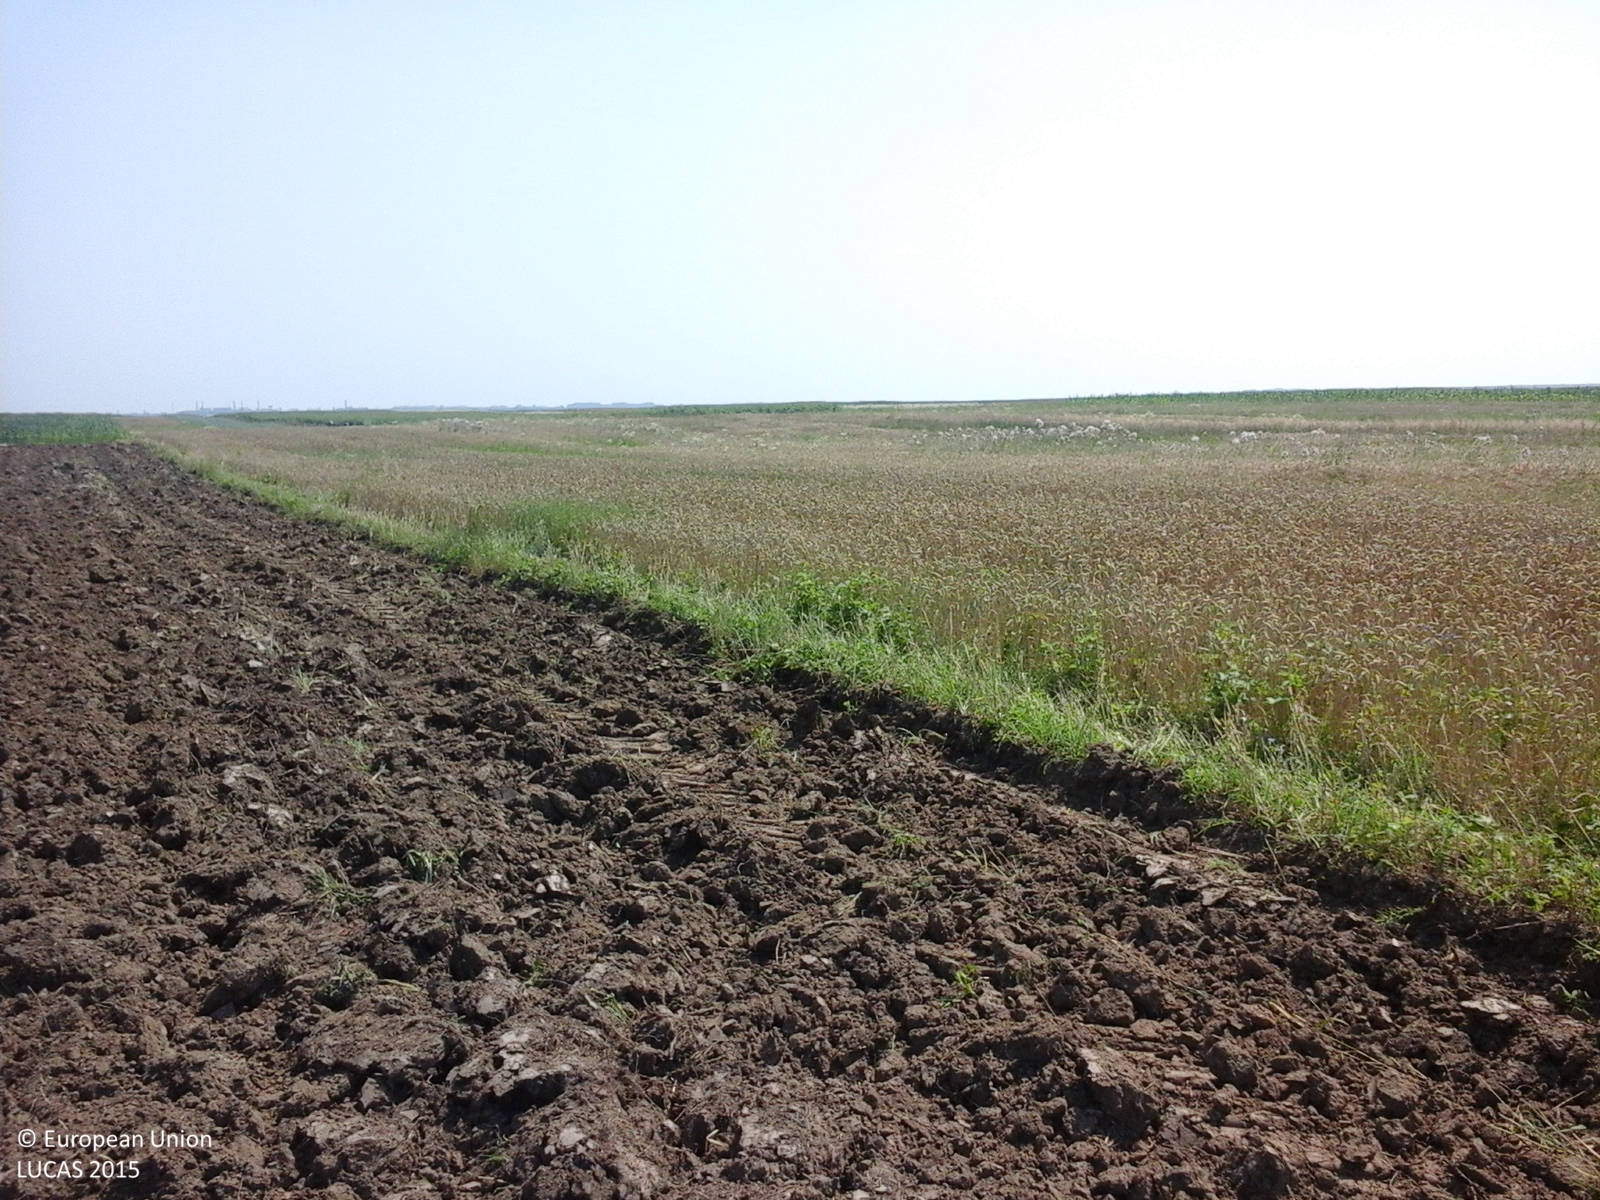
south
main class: Cropland
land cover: Barley
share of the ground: < 10 %
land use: Agriculture (excluding fallow land and kitchen gardens)
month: July
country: RO
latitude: 44.7305
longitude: 25.5374
